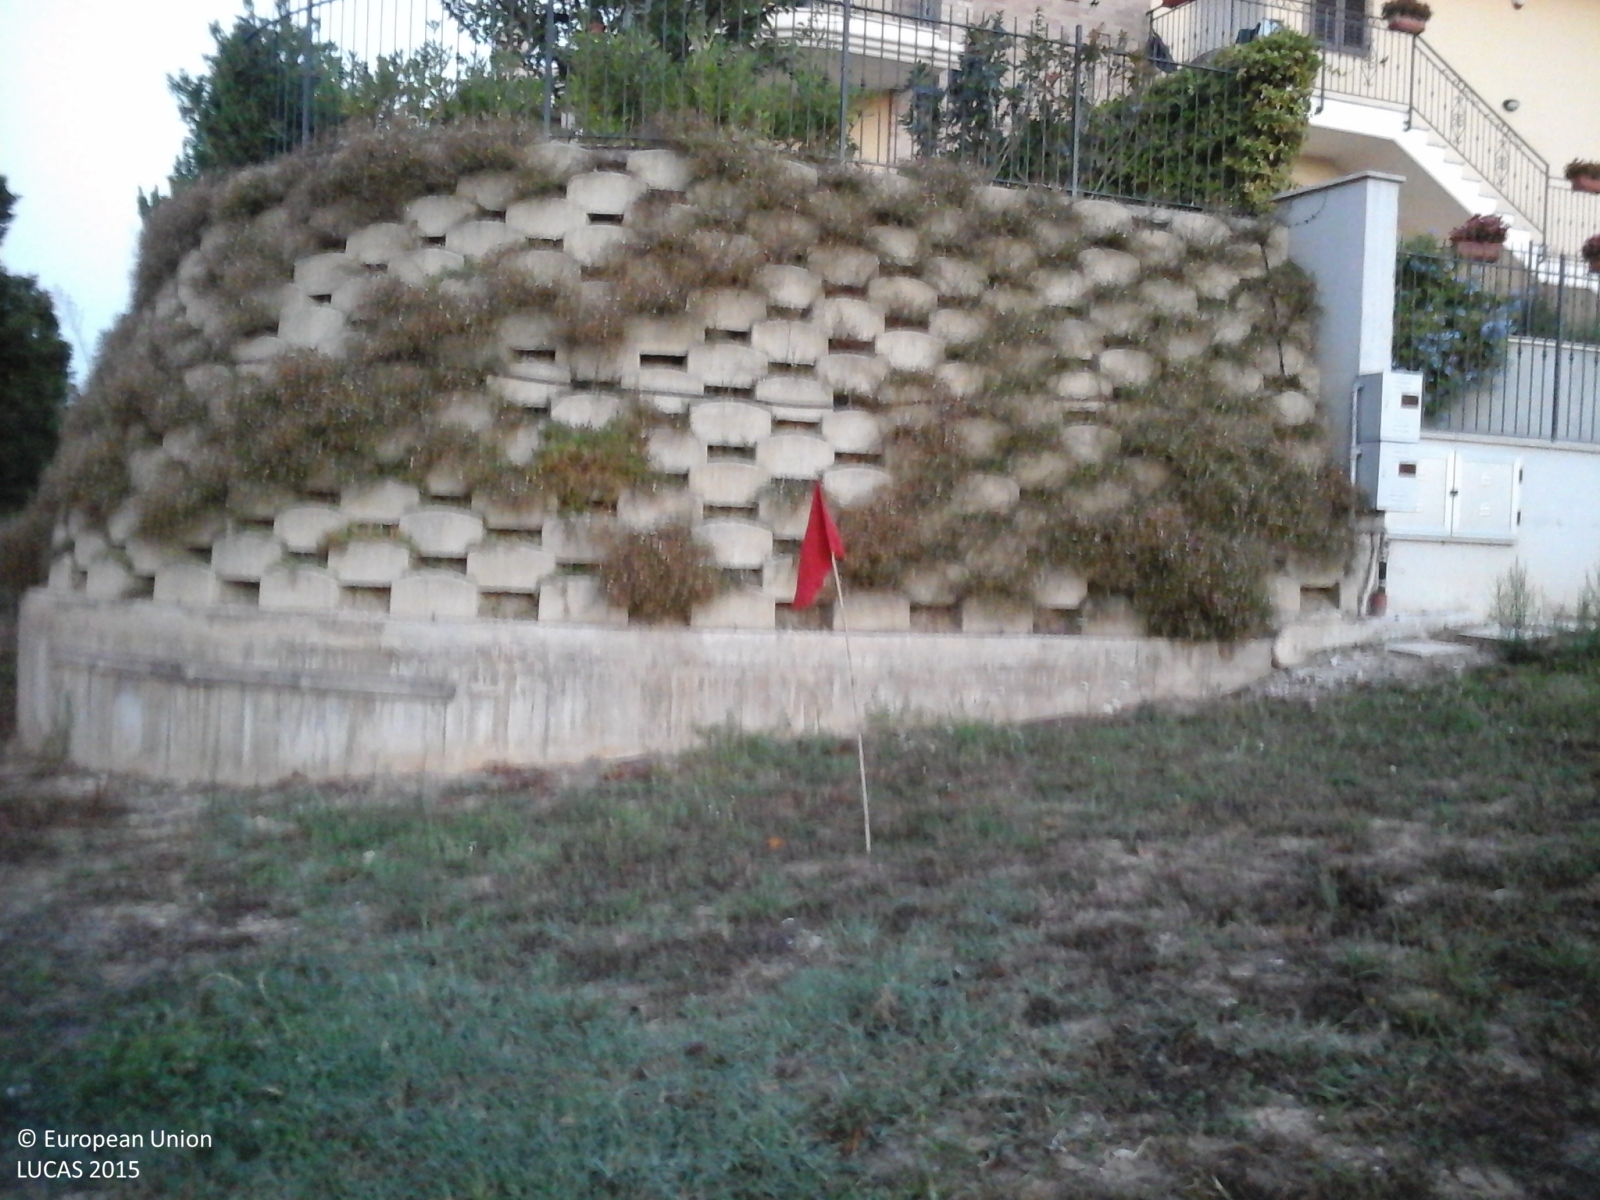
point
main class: Grassland
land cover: Spontaneously vegetated surfaces
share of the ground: > 75 %
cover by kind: herbaceous plants 90 %, unconsolidated bare surface 10 %
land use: Residential
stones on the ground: < 10 %
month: August
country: IT
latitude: 42.8892
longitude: 13.8221
